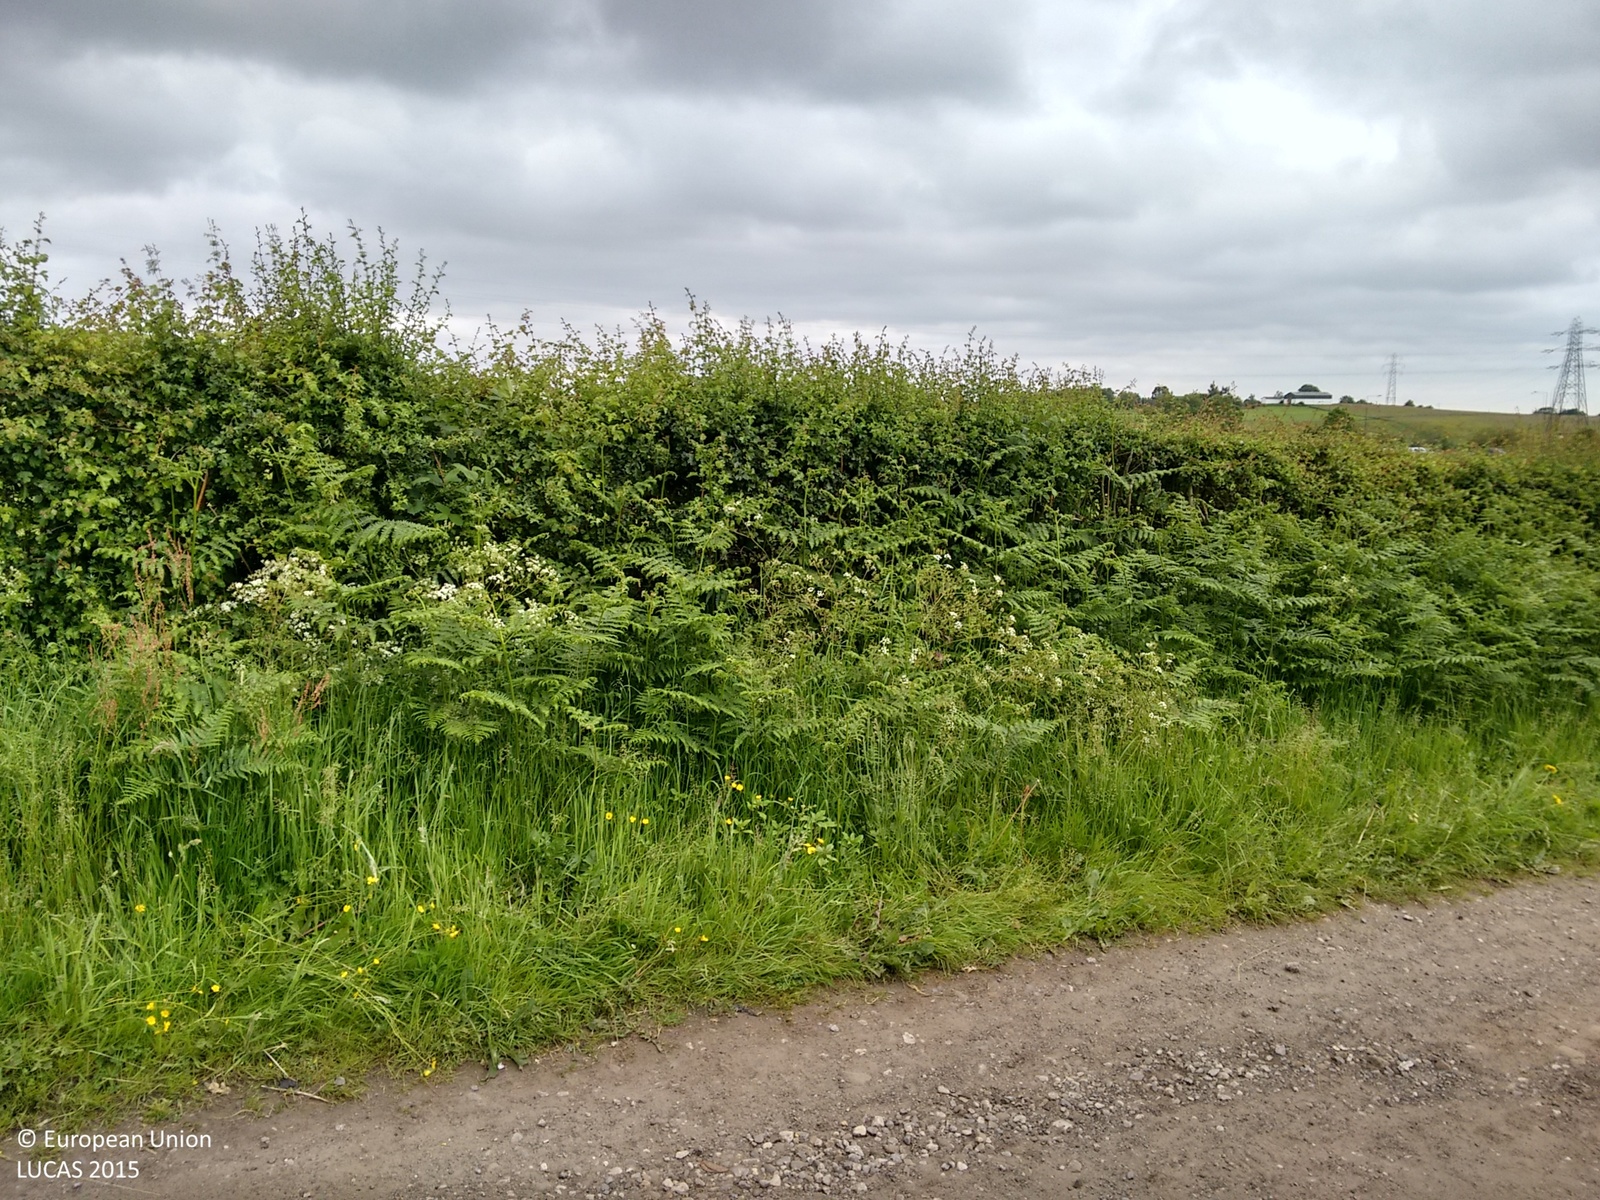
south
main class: Grassland
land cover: Grassland without tree/shrub cover
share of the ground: > 75 %
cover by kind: herbaceous plants 100 %
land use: Agriculture (excluding fallow land and kitchen gardens)
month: June
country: GB
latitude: 53.5691
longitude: -2.1549
